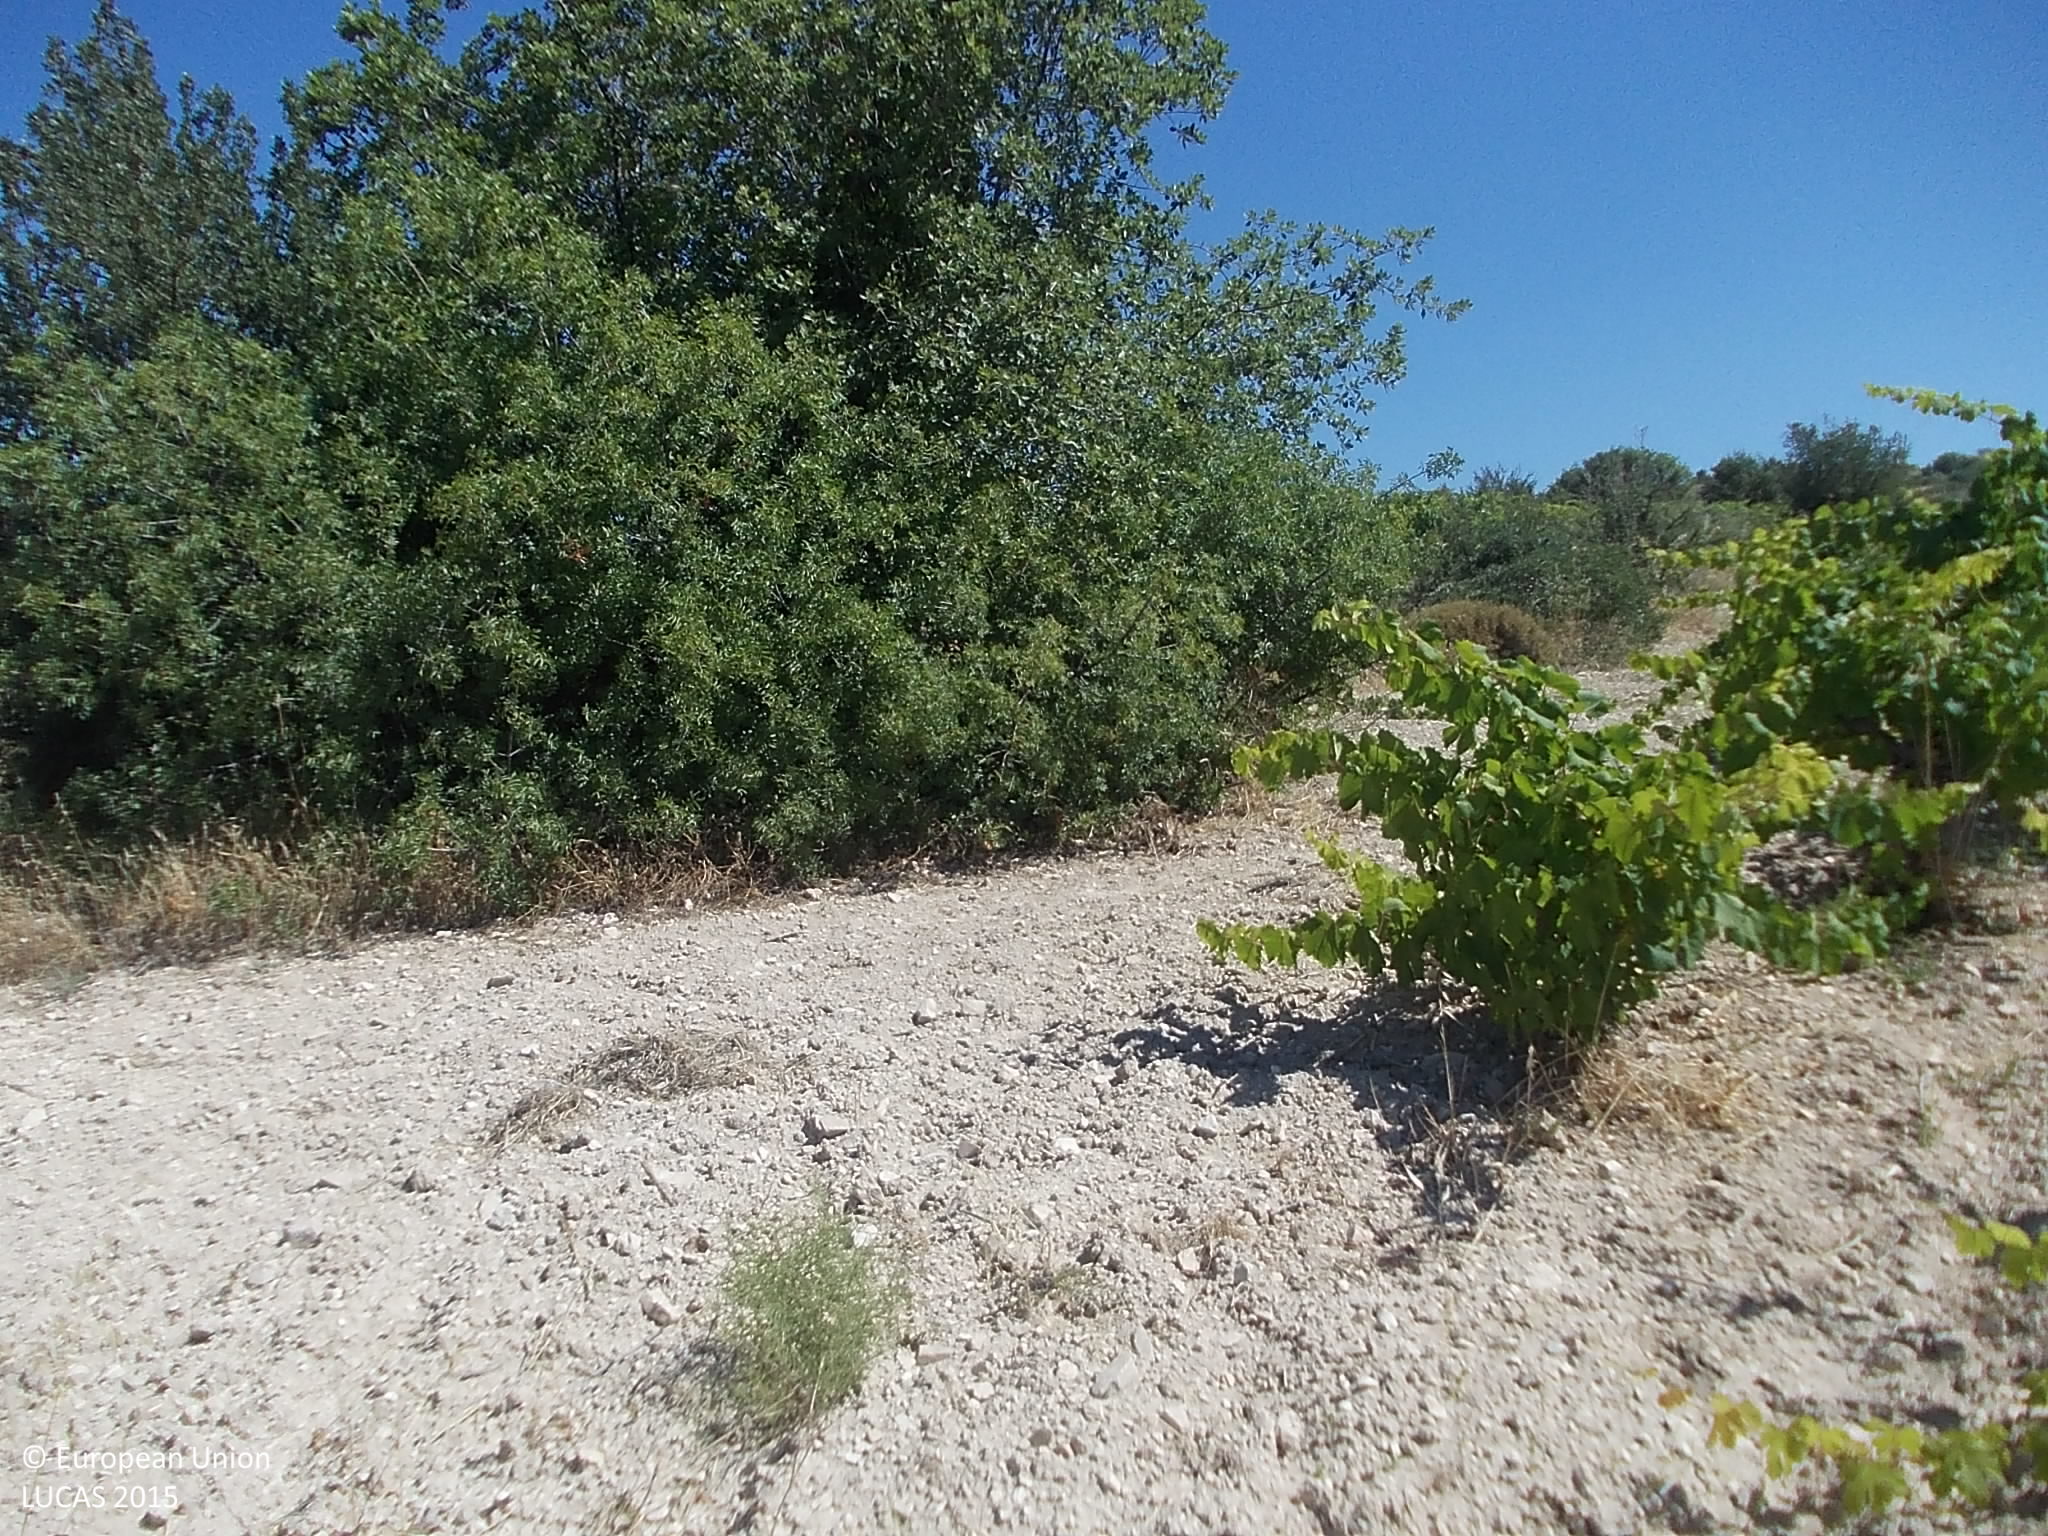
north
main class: Cropland
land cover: Vineyards
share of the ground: 25 - 50 %
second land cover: Other bare soil
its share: > 75 %
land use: Agriculture (excluding fallow land and kitchen gardens)
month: July
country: CY
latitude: 34.8585
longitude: 32.7463
